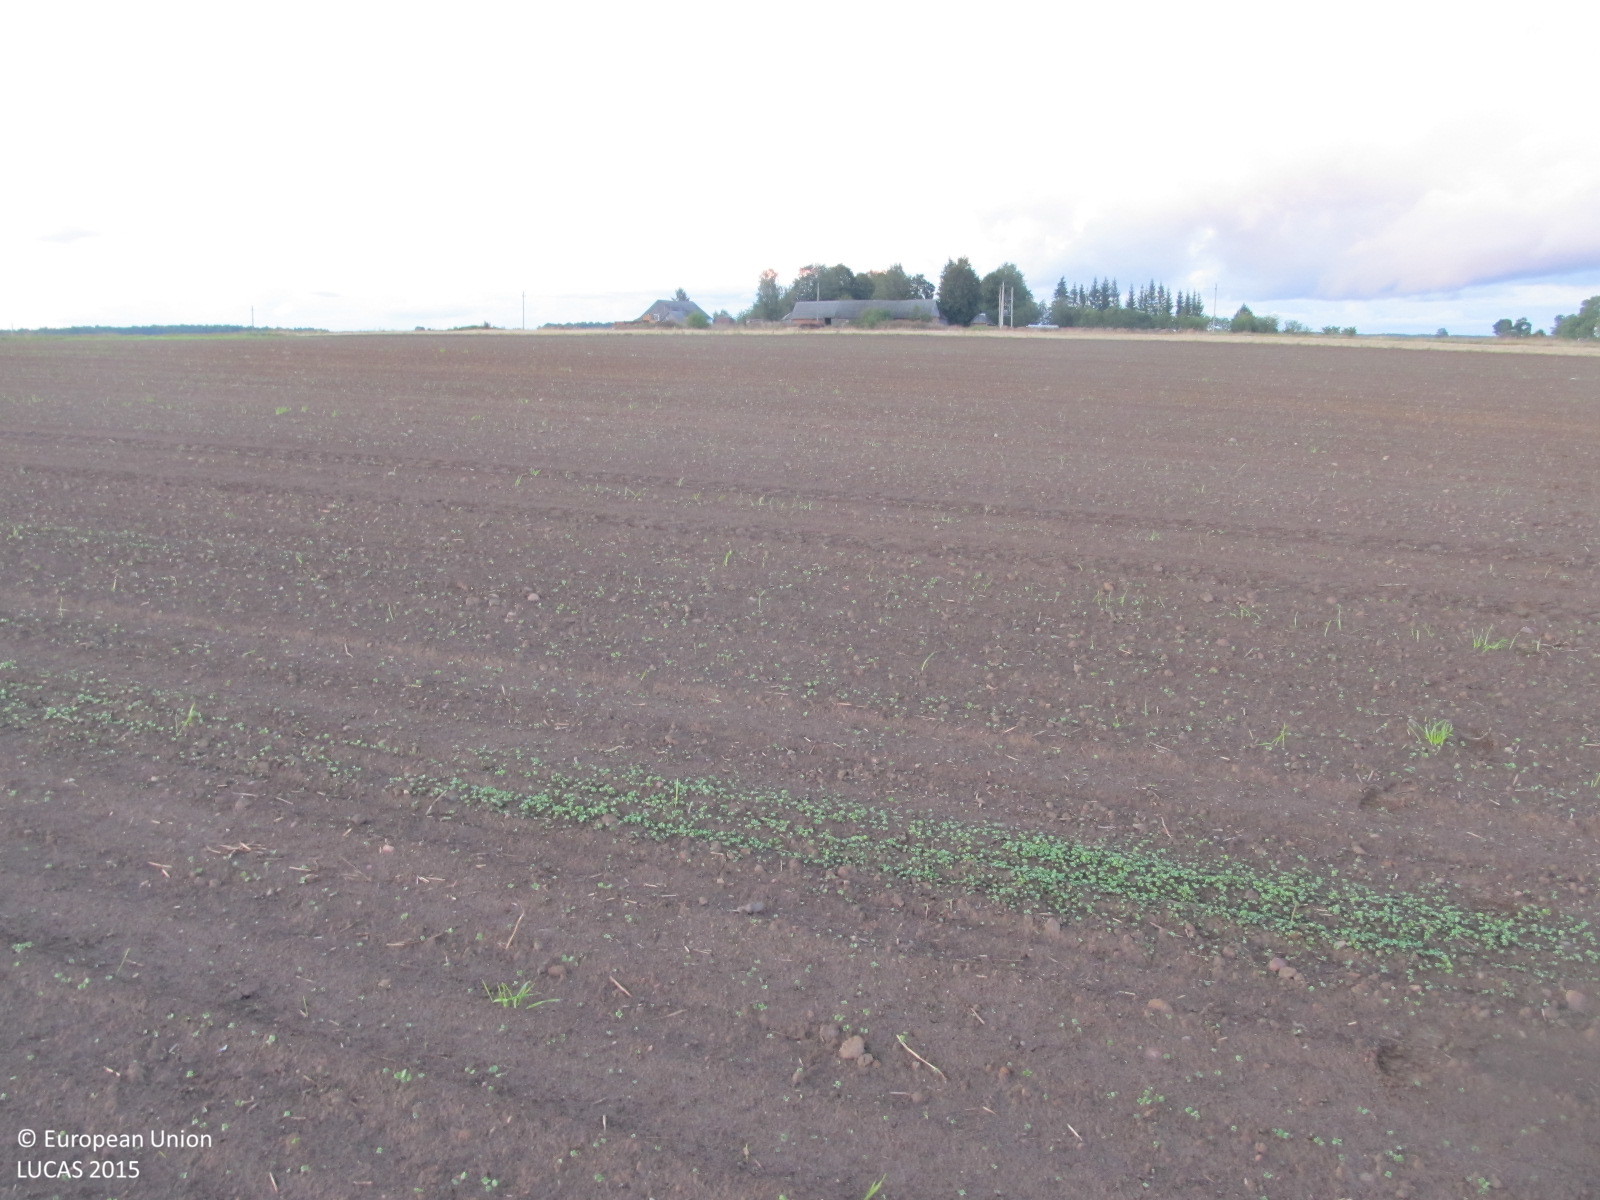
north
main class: Cropland
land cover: Rape and turnip rape
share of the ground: < 10 %
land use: Agriculture (excluding fallow land and kitchen gardens)
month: September
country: LT
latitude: 56.1628
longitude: 23.1615
